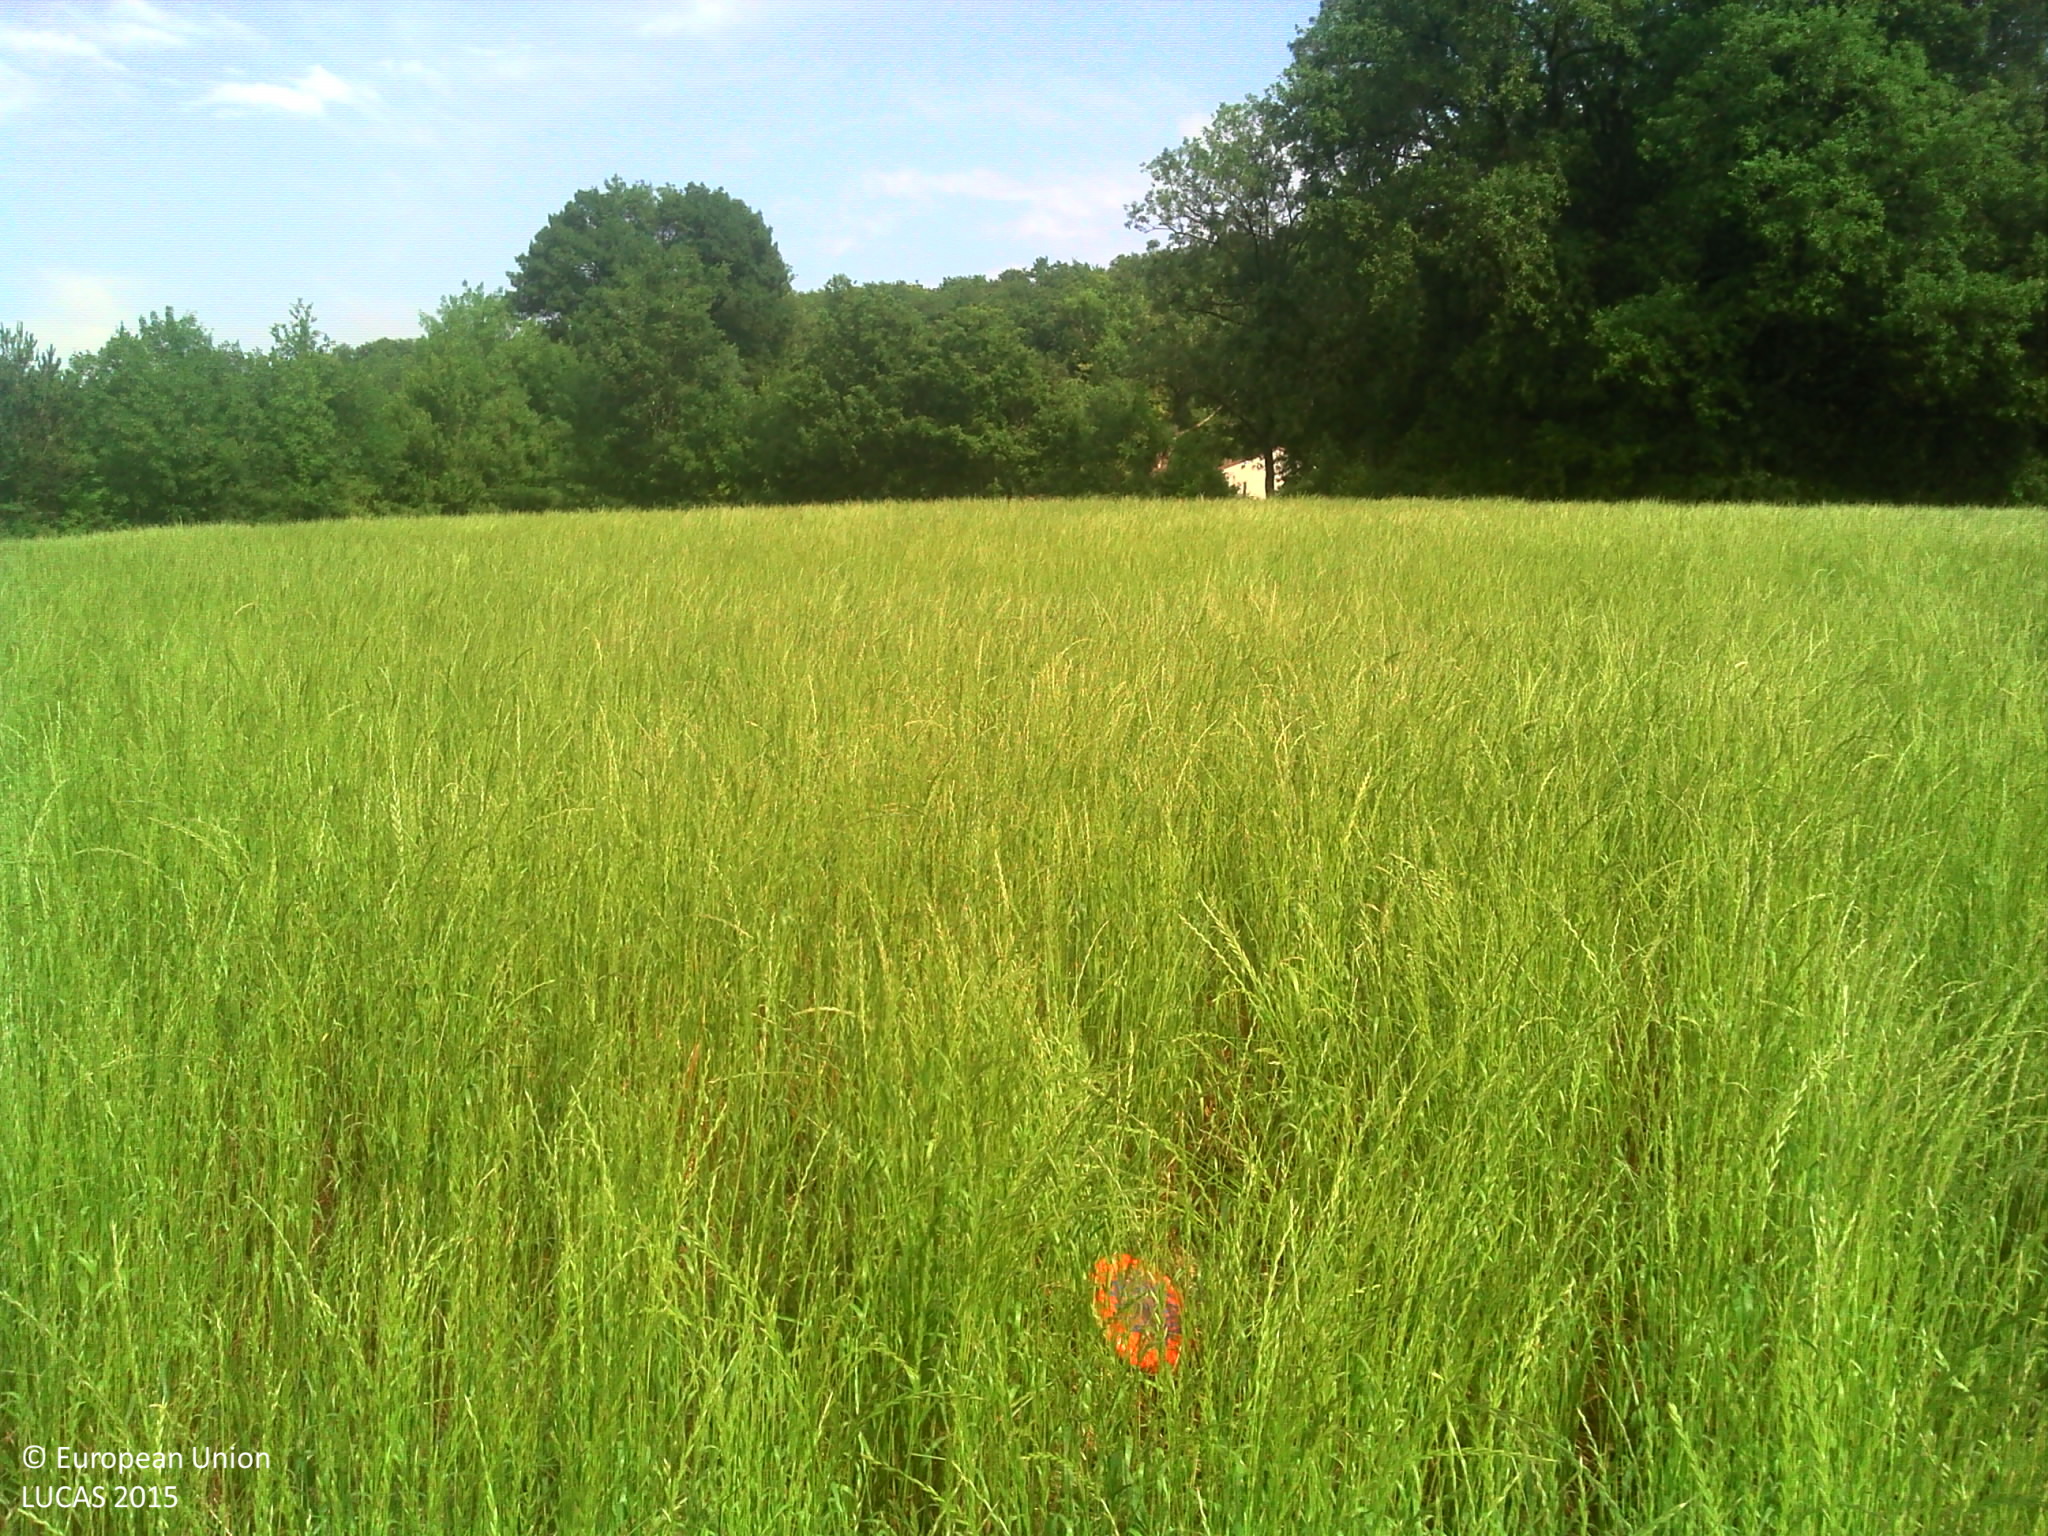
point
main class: Cropland
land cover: Temporary grasslands
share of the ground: > 75 %
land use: Agriculture (excluding fallow land and kitchen gardens)
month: June
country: FR
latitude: 43.6952
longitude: 1.9767
